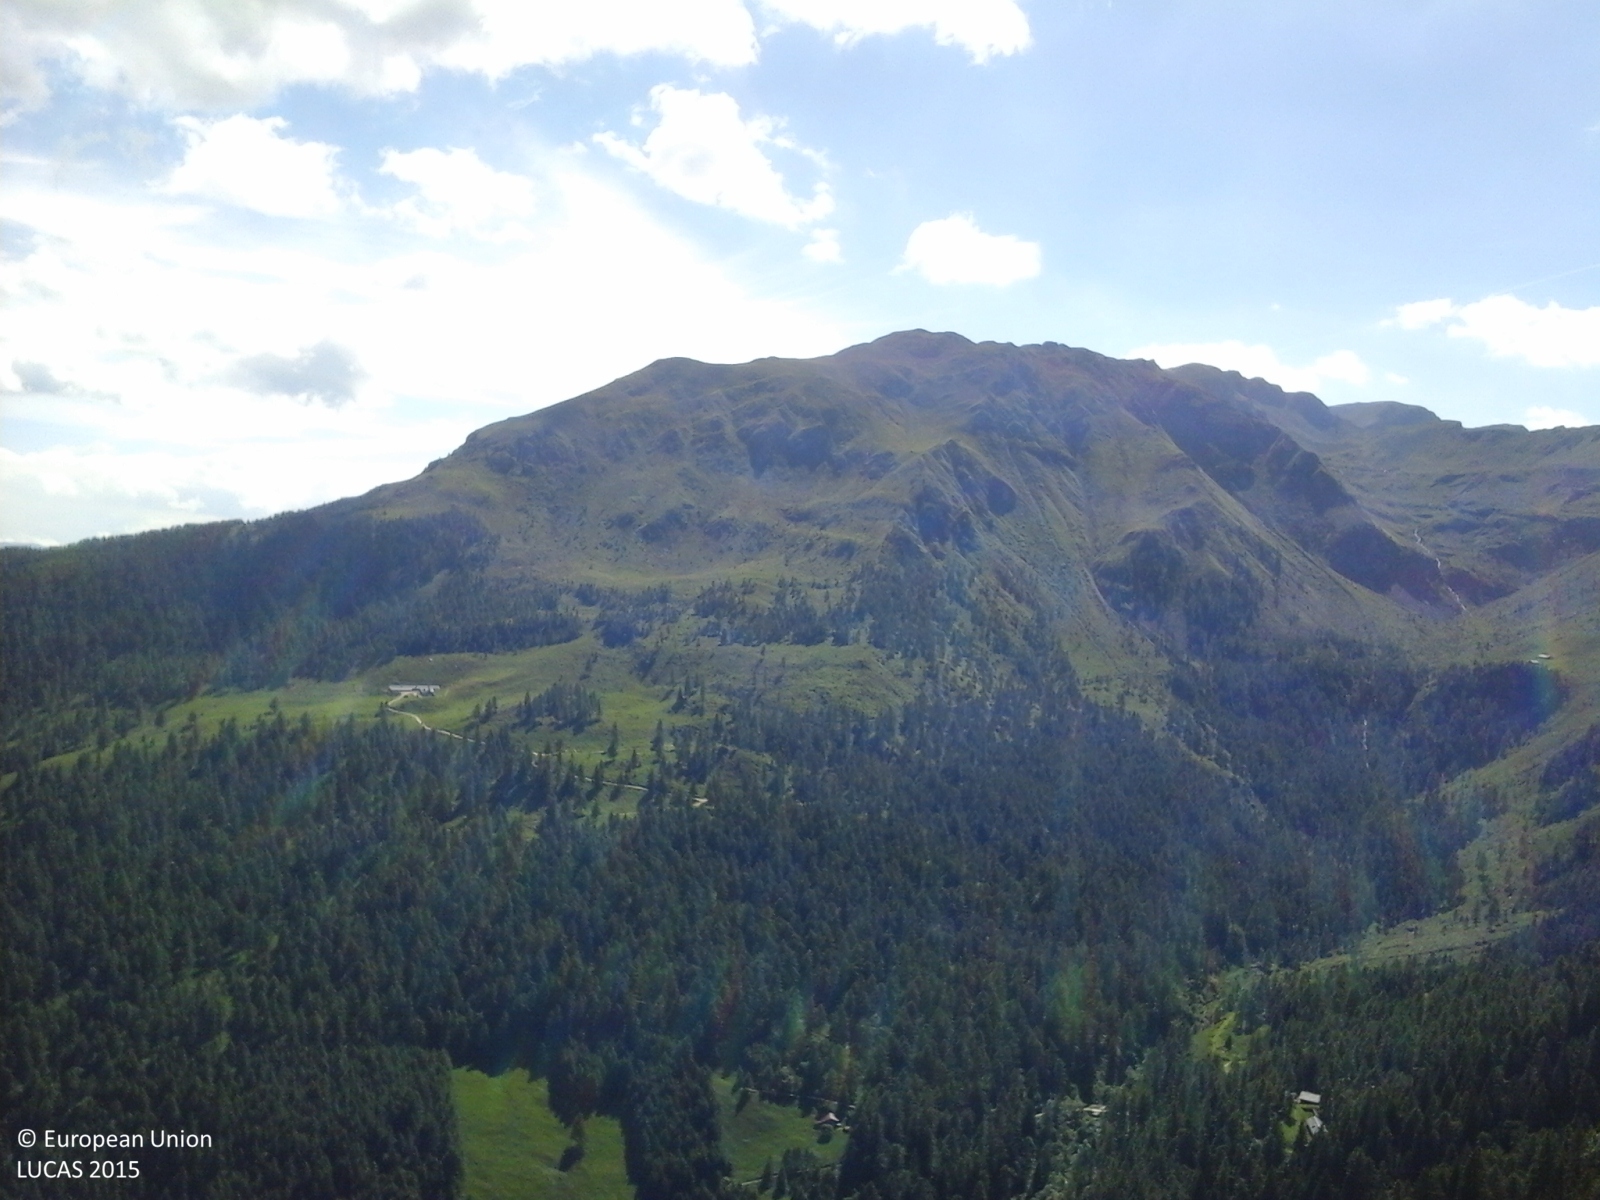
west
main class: Grassland
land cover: Grassland with sparse tree/shrub cover
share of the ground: > 75 %
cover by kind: herbaceous plants 95 %, coniferous forest trees 5 %
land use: Agriculture (excluding fallow land and kitchen gardens)
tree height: > 5 m
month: June
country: IT
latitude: 46.1077
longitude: 11.4083
